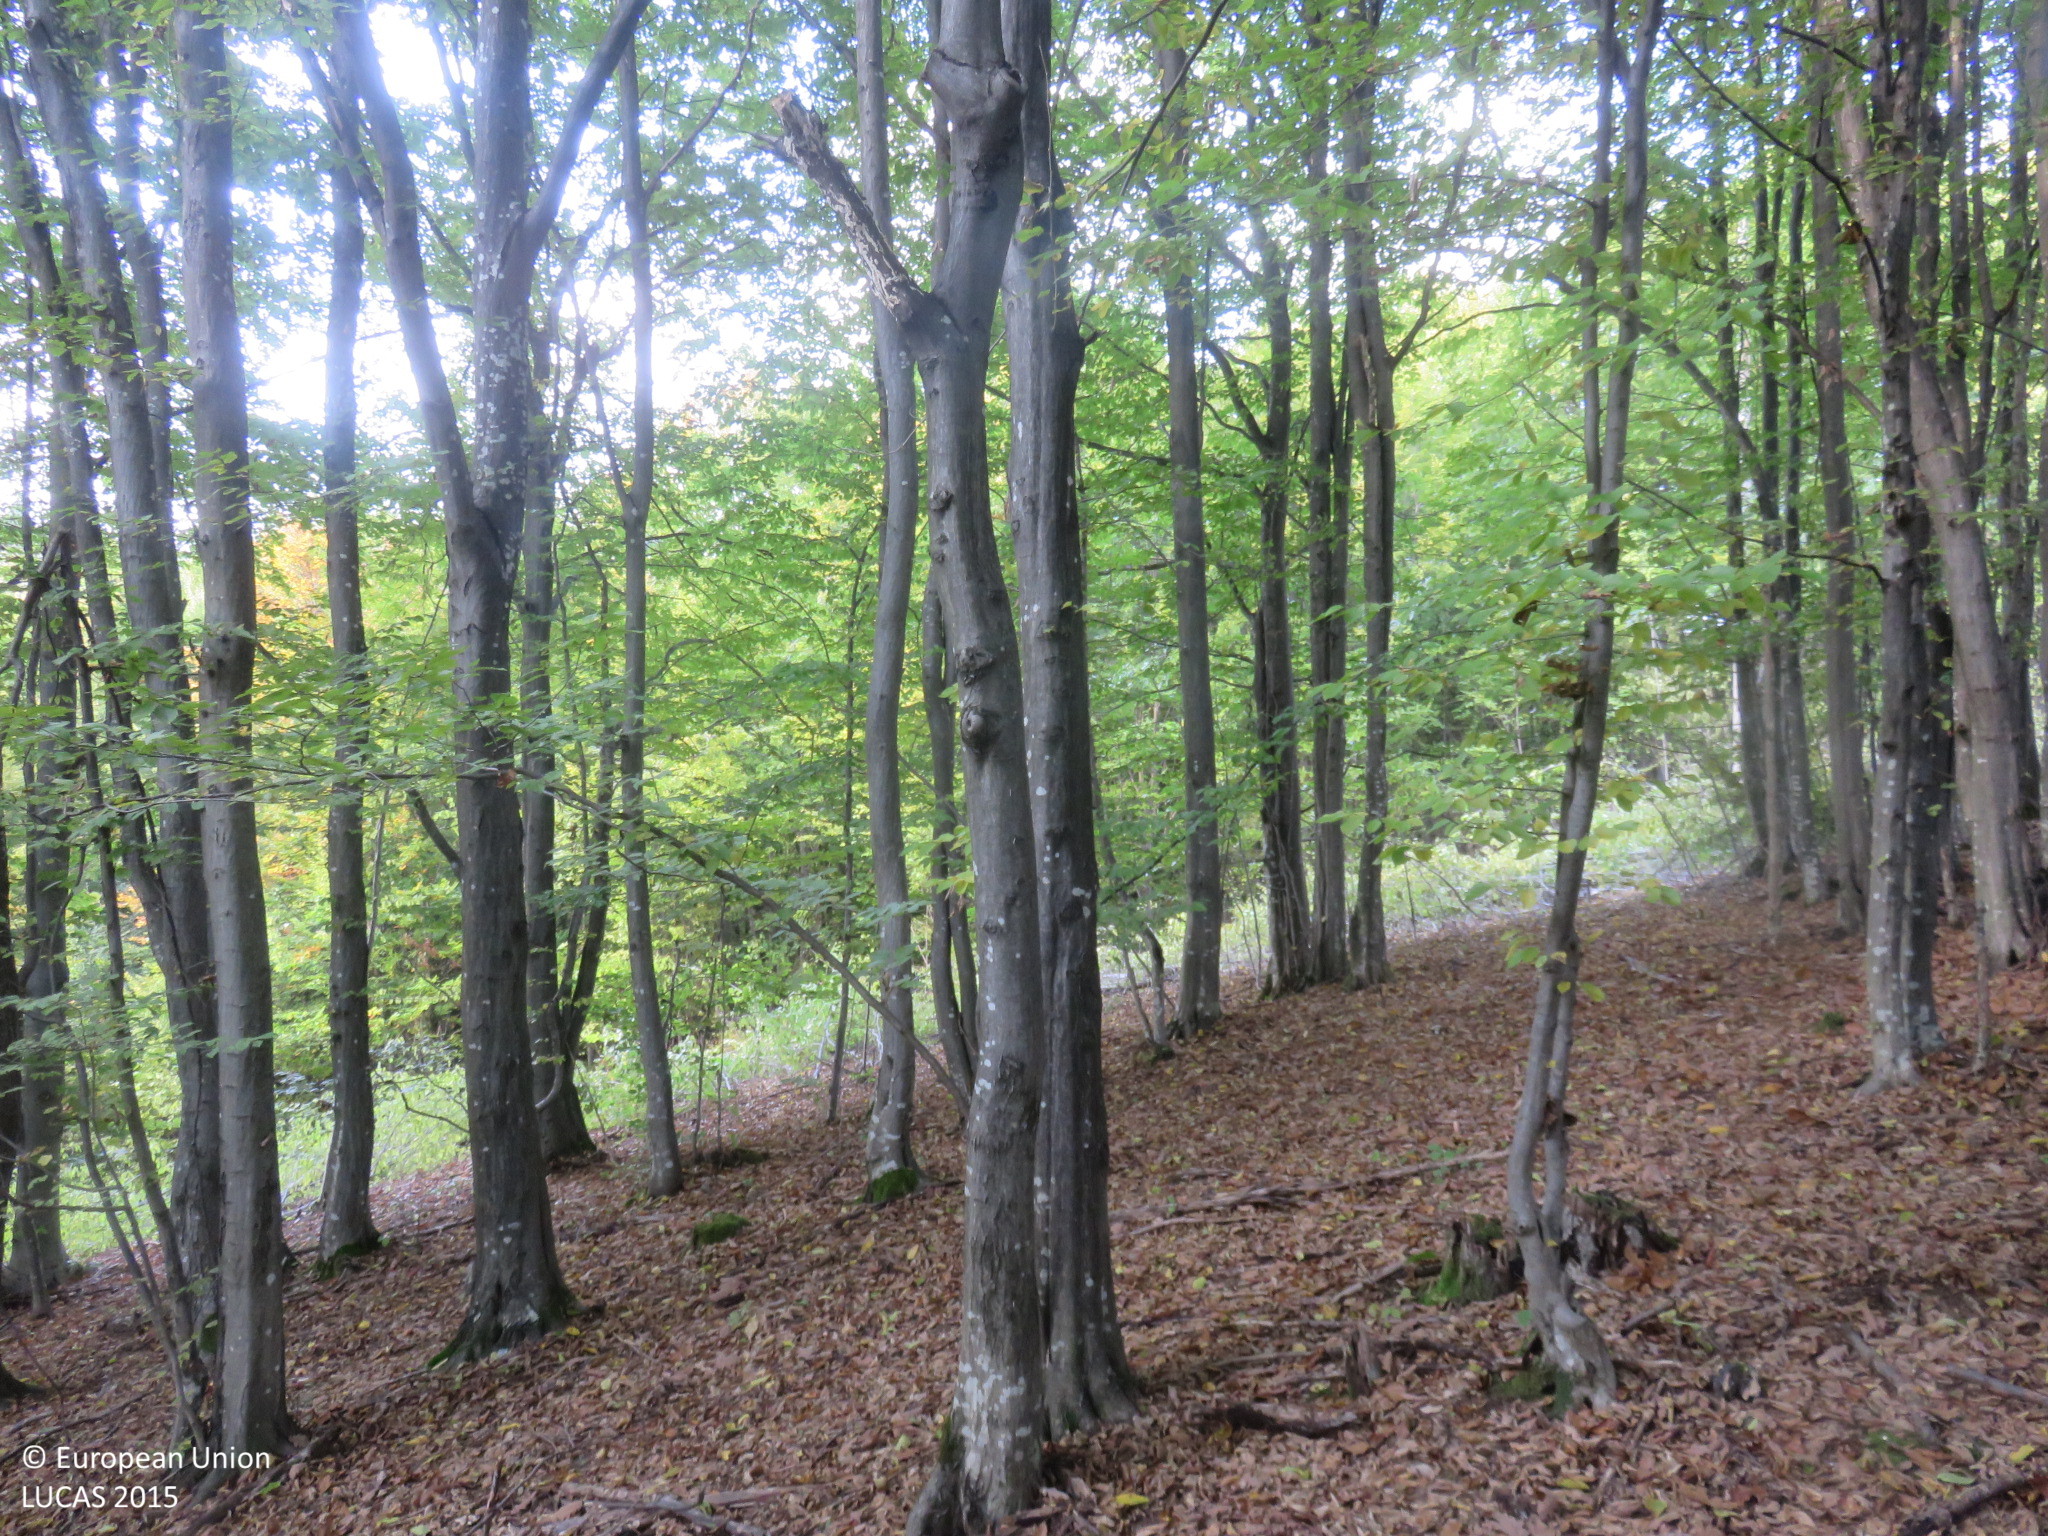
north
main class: Woodland
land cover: Broadleaved woodland
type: beech forest
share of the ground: > 75 %
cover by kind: broadleaved forest trees 95 %, shrubs 5 %
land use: Forestry
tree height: > 5 m
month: October
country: BG
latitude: 42.8384
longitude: 24.9528
